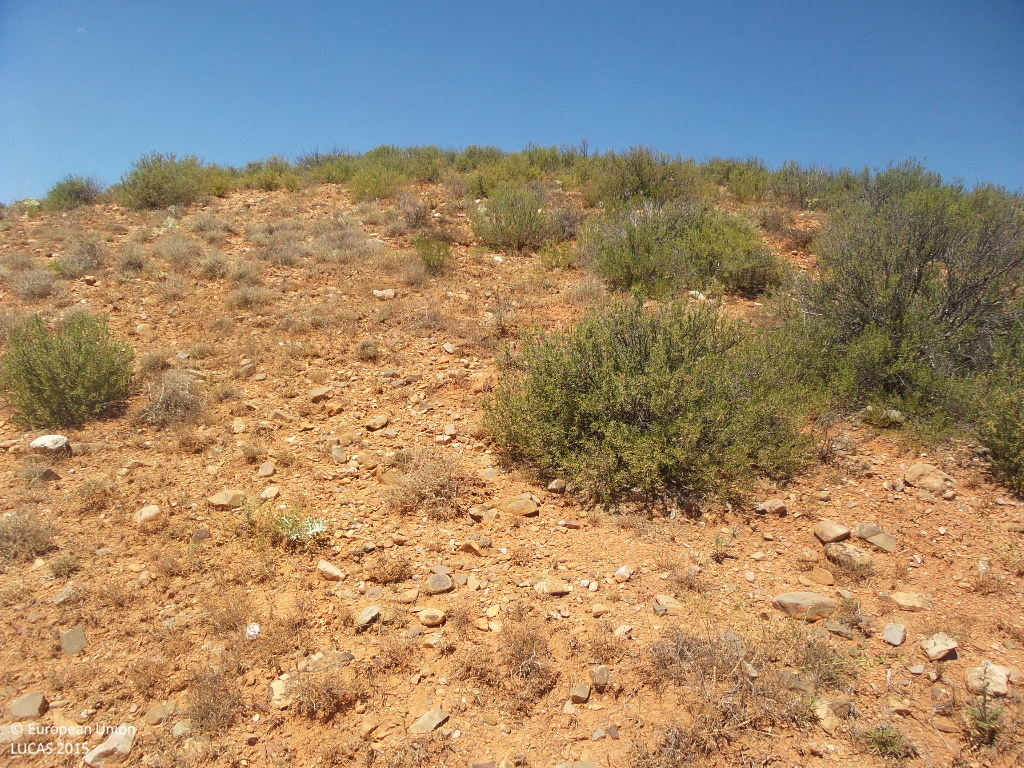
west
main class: Shrubland
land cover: Shrubland without tree cover
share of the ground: 25 - 50 %
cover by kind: unconsolidated bare surface 50 %, shrubs 40 %, herbaceous plants 10 %
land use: Semi-natural and natural areas not in use
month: July
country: ES
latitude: 41.3761
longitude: -2.1183
